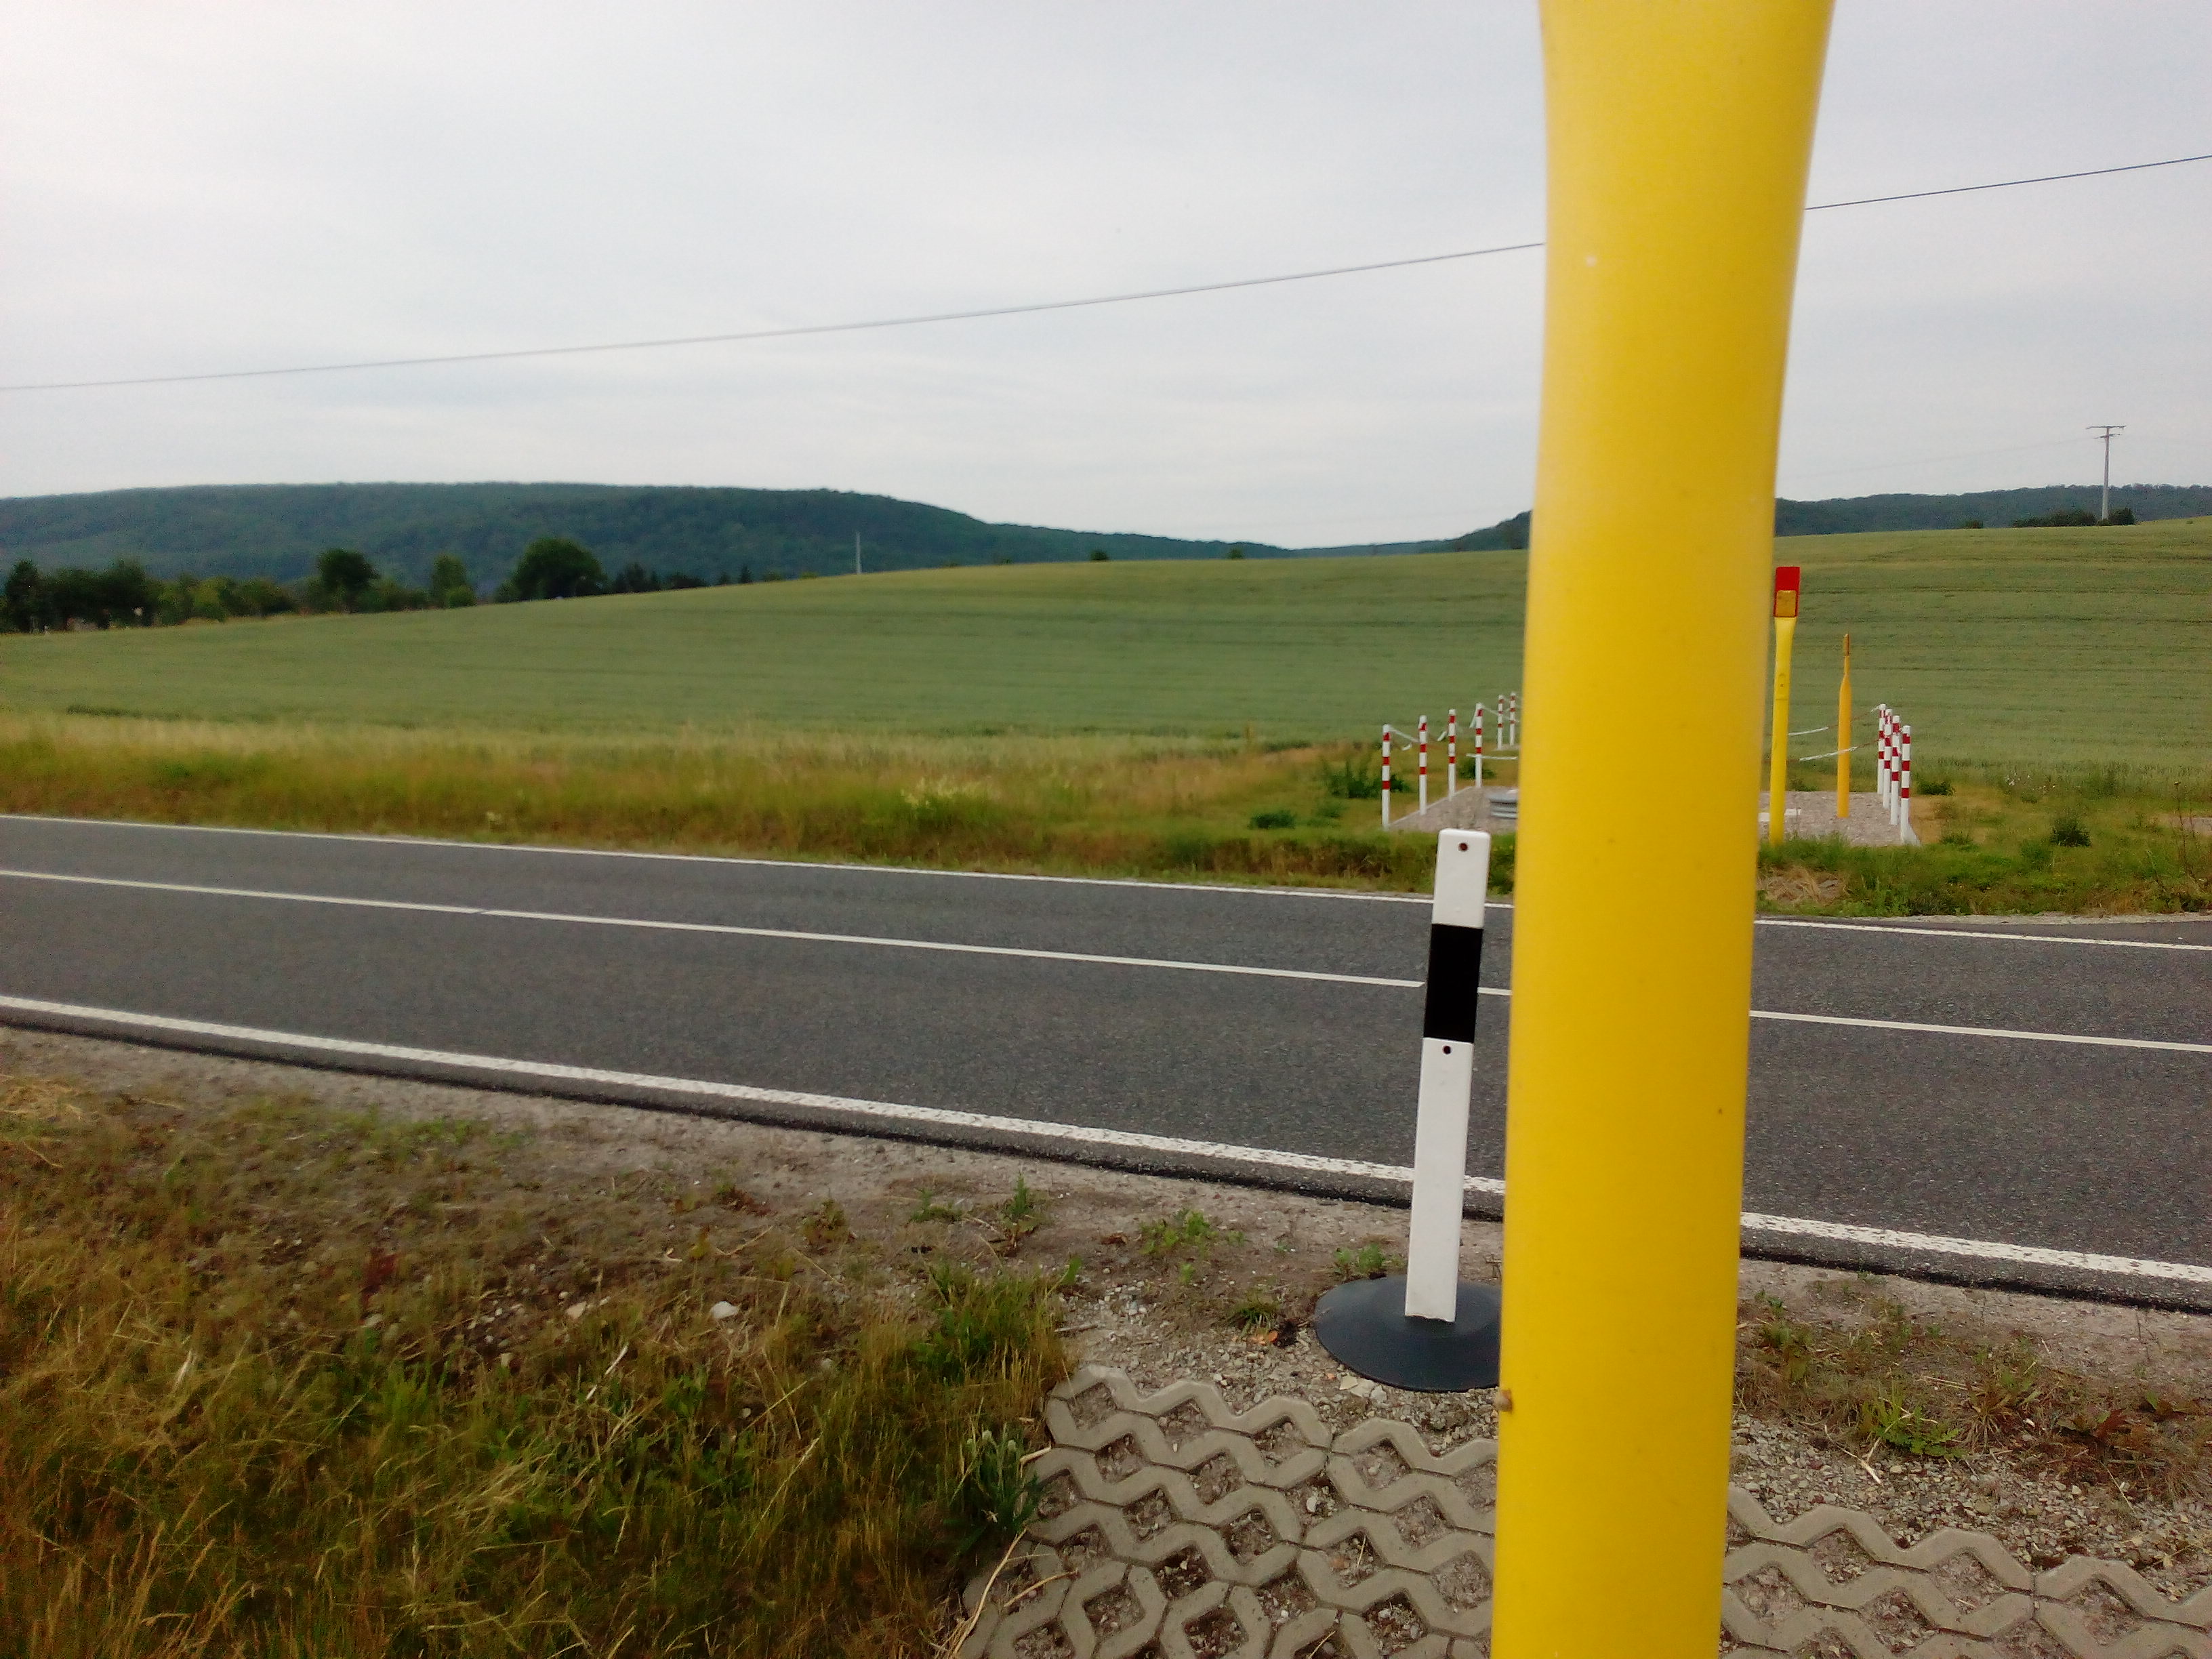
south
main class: Cropland
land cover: Common wheat
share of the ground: > 75 %
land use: Agriculture (excluding fallow land and kitchen gardens)
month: June
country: DE
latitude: 51.3489
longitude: 10.9617
